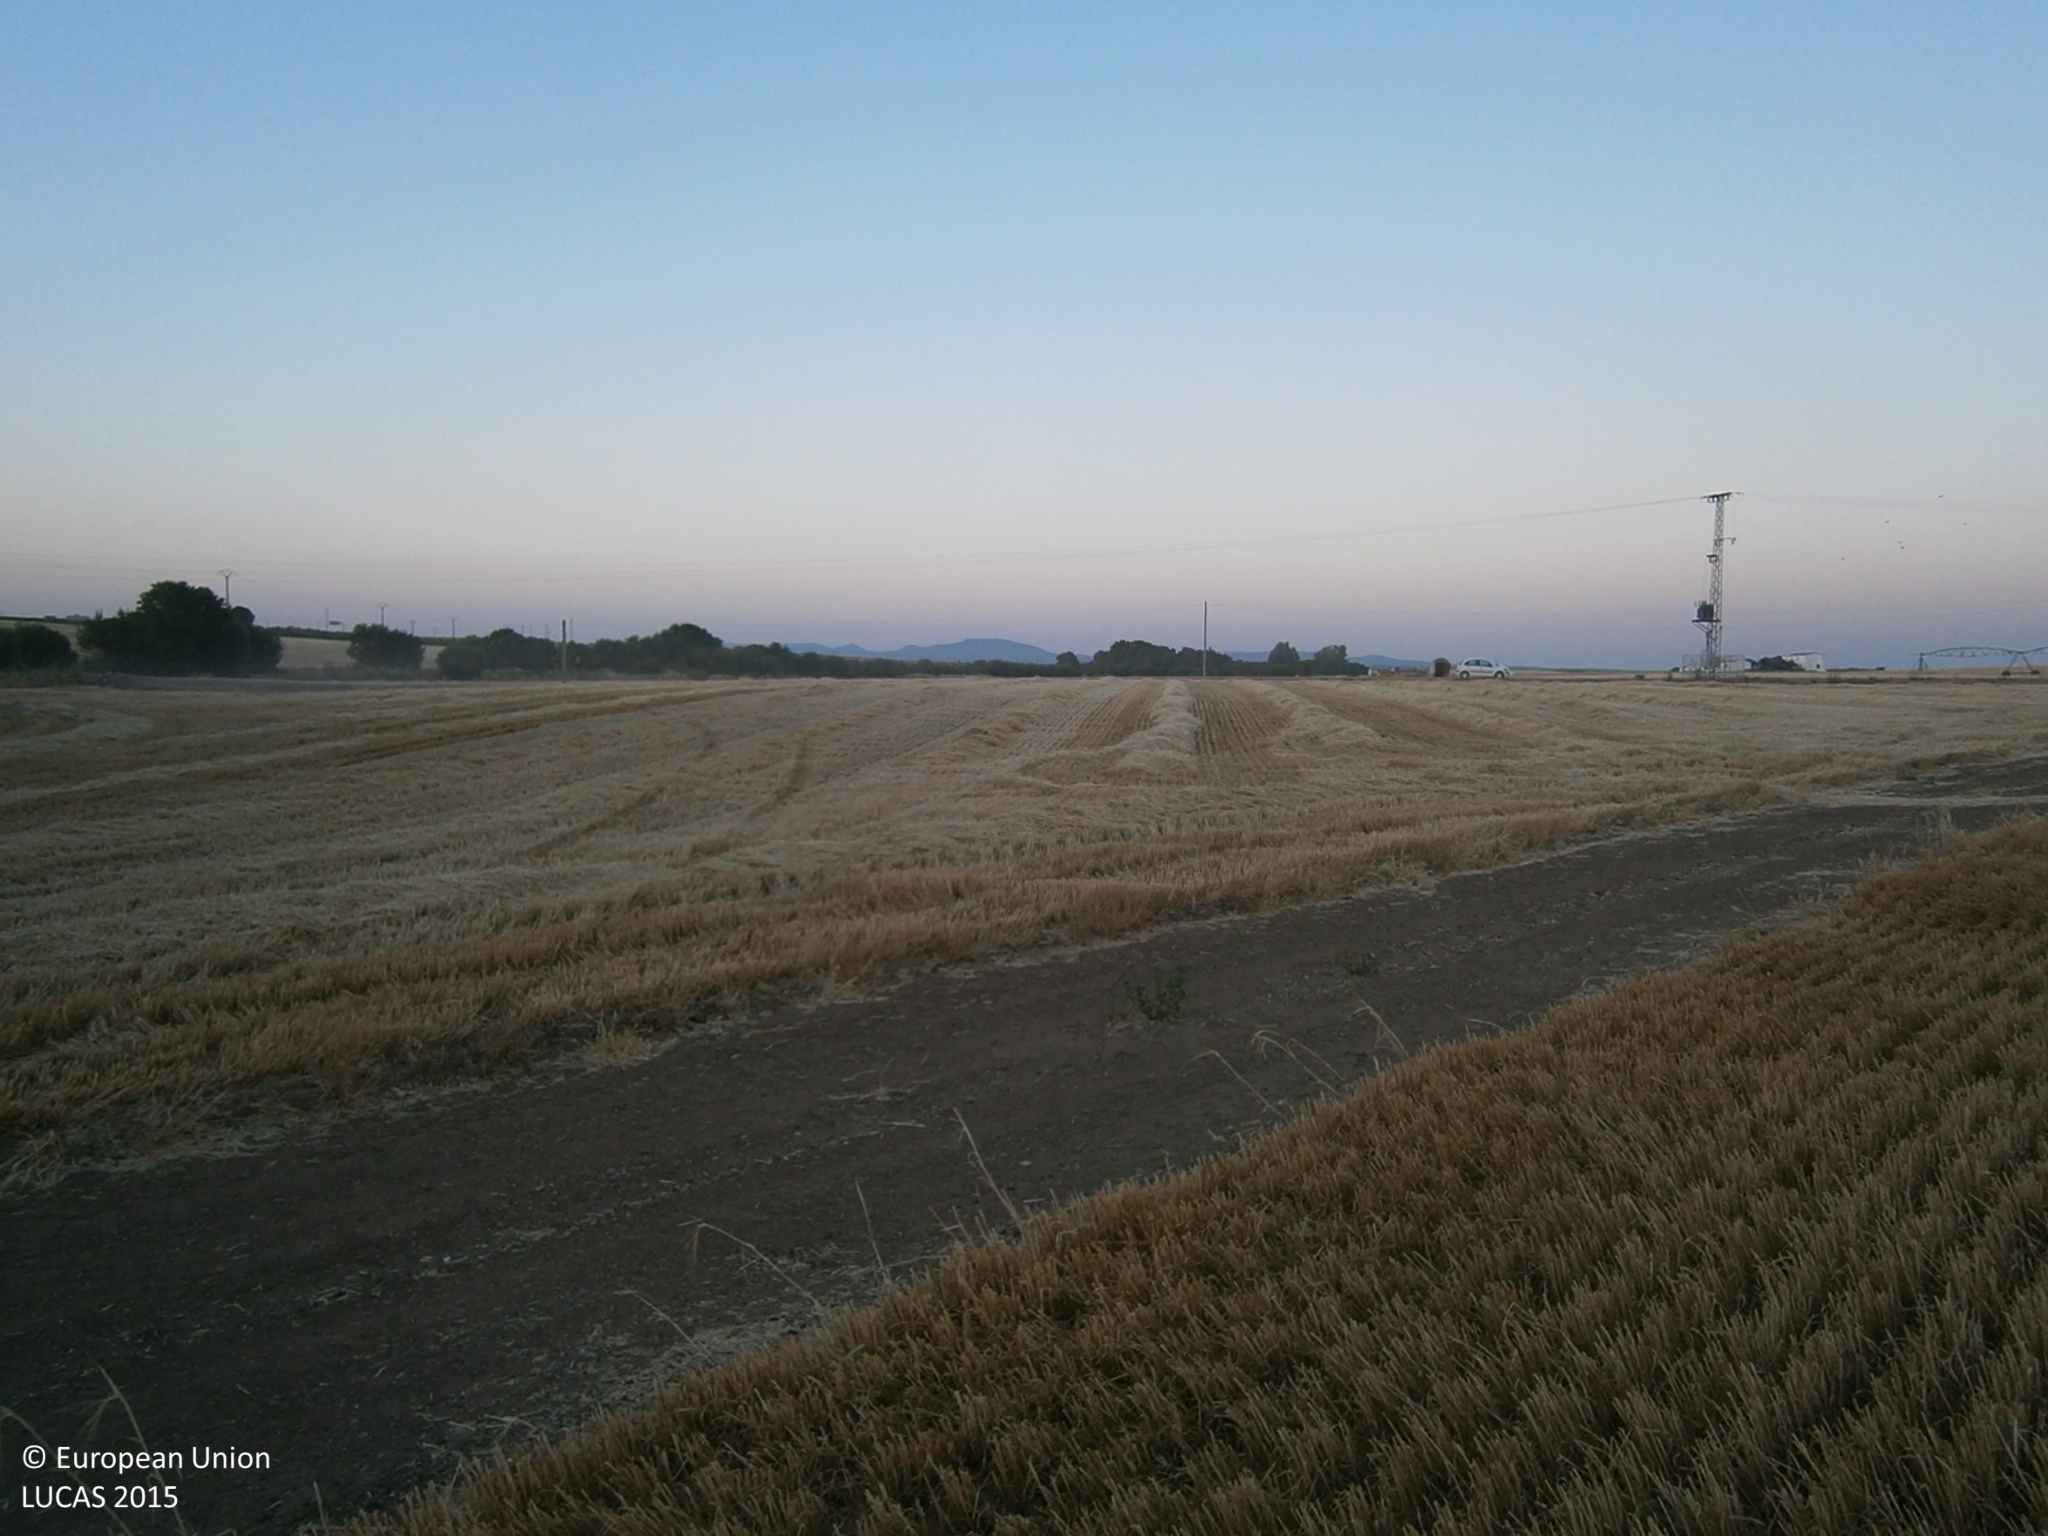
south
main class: Cropland
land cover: Rape and turnip rape
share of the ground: > 75 %
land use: Agriculture (excluding fallow land and kitchen gardens)
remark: Harvested field
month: June
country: ES
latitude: 38.7426
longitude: -6.8508
